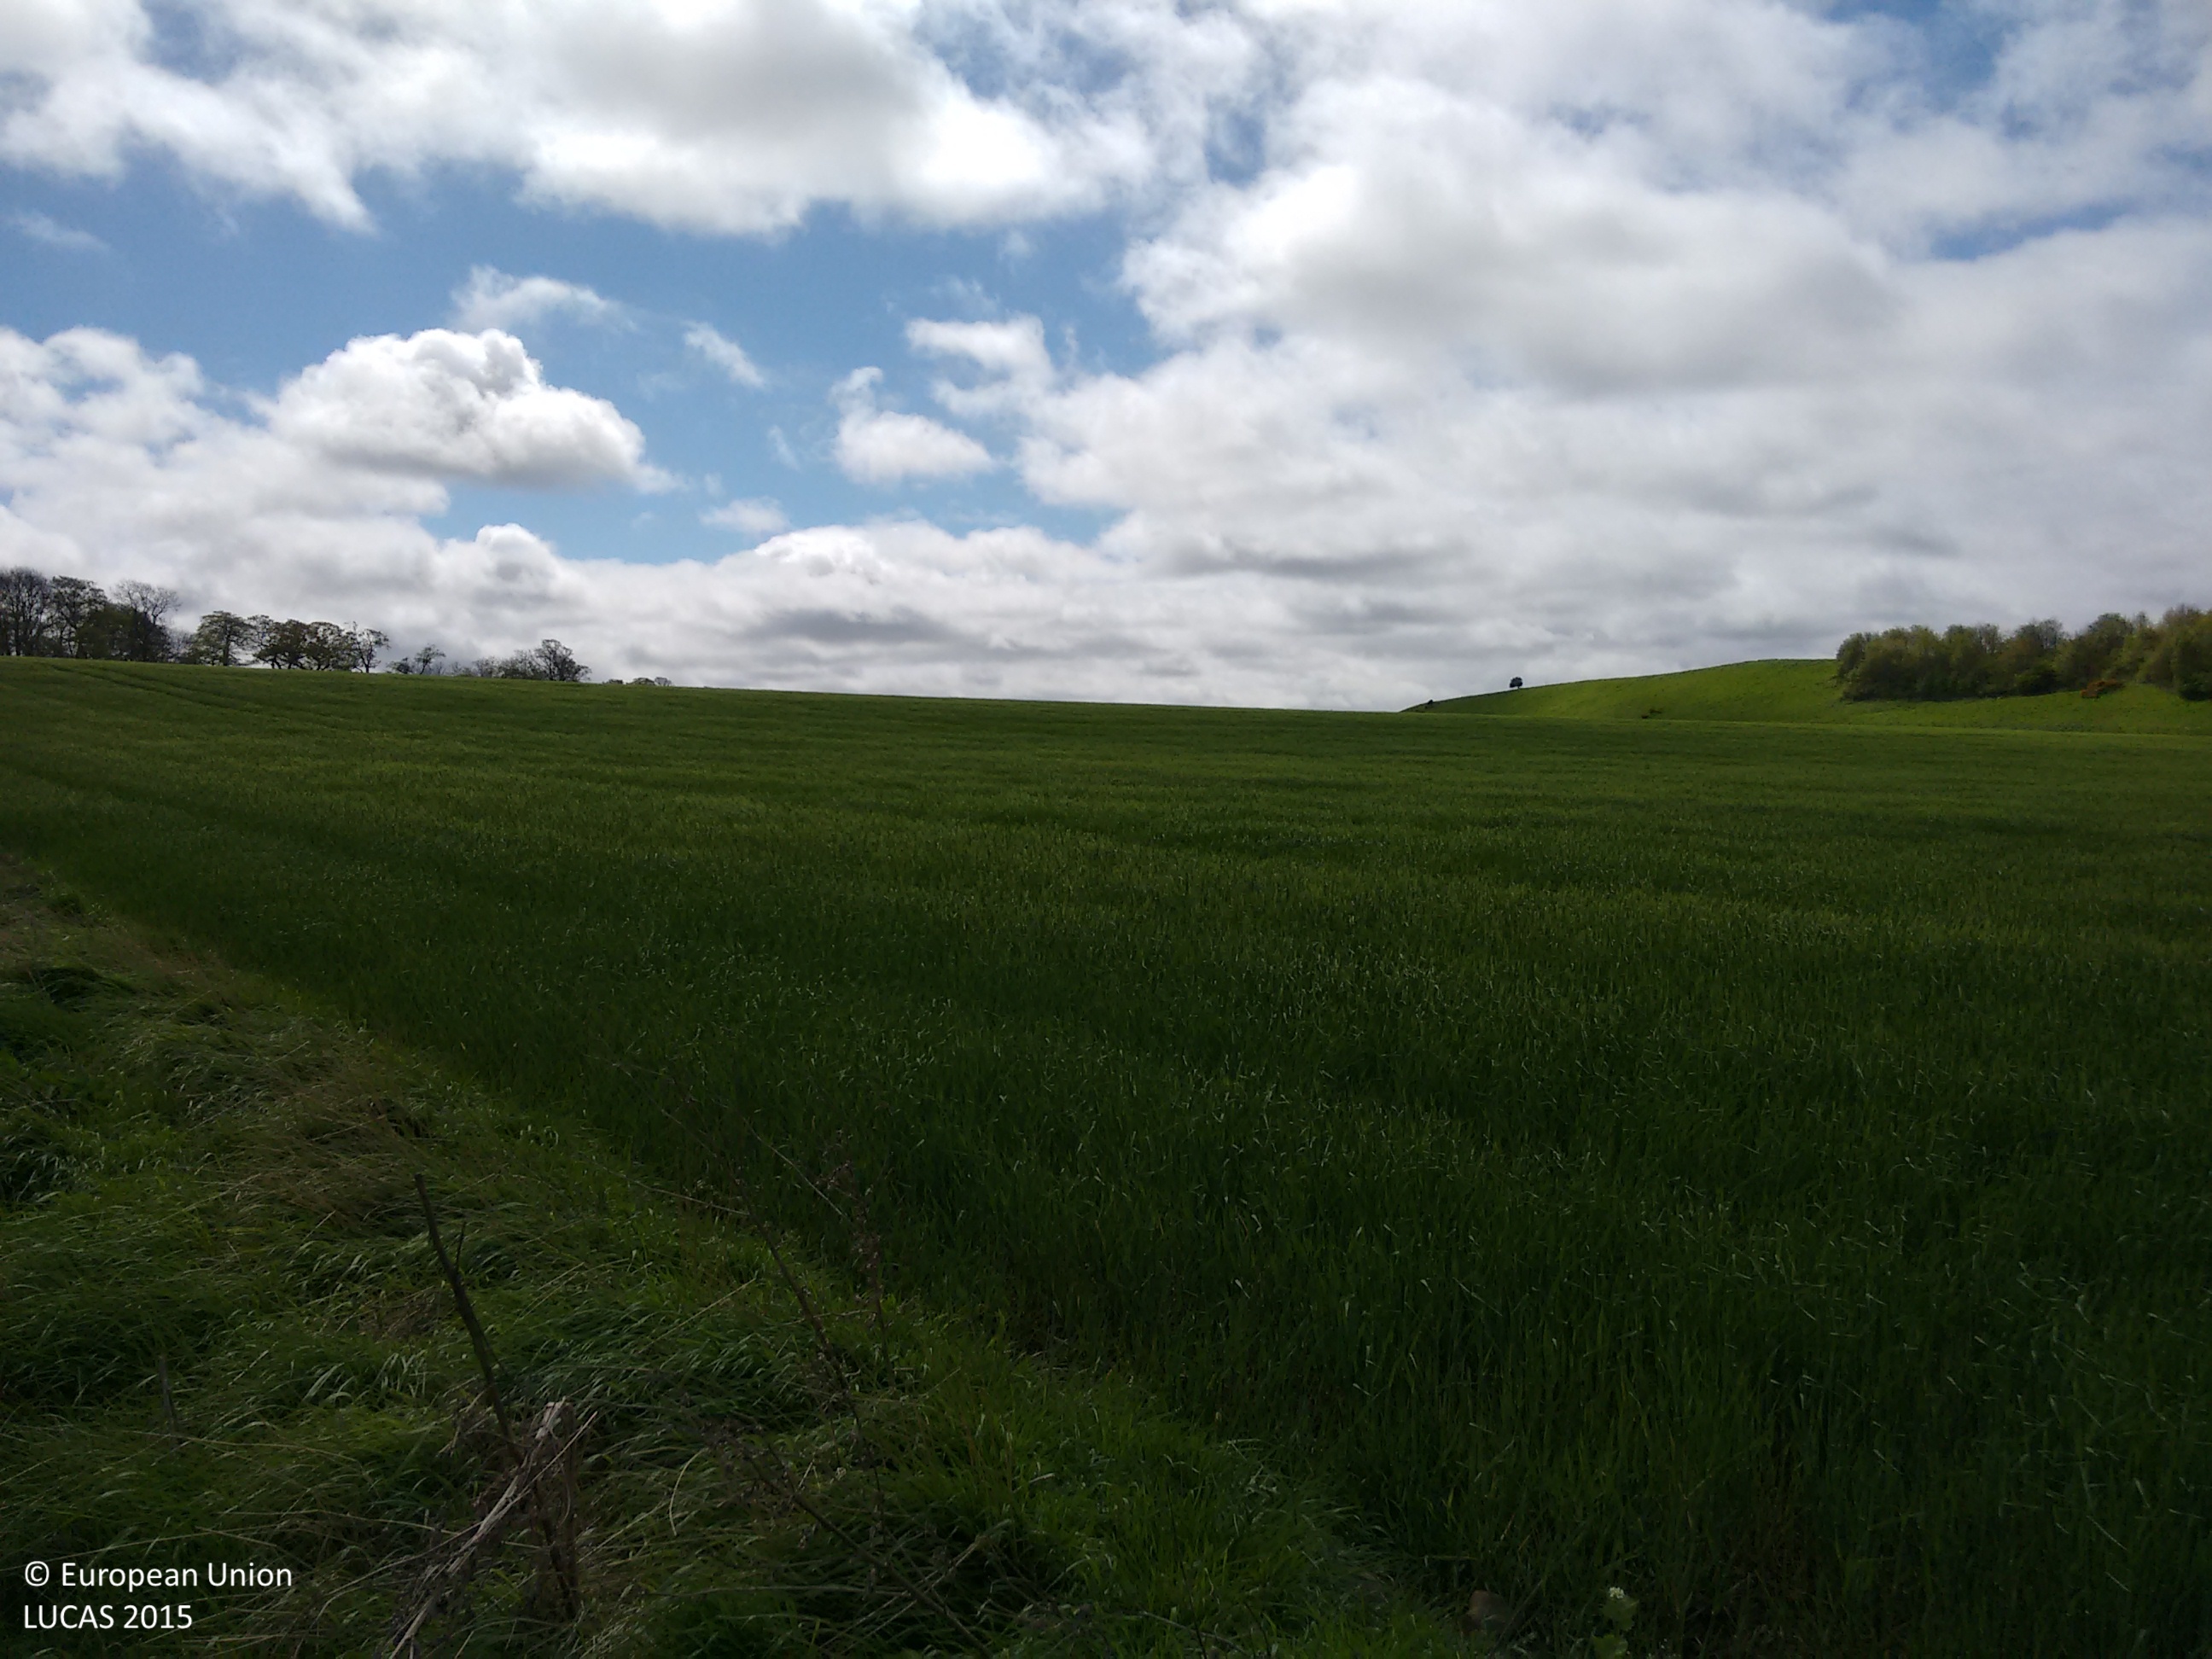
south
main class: Cropland
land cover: Barley
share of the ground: > 75 %
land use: Agriculture (excluding fallow land and kitchen gardens)
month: May
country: GB
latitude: 55.9778
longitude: -3.3597
